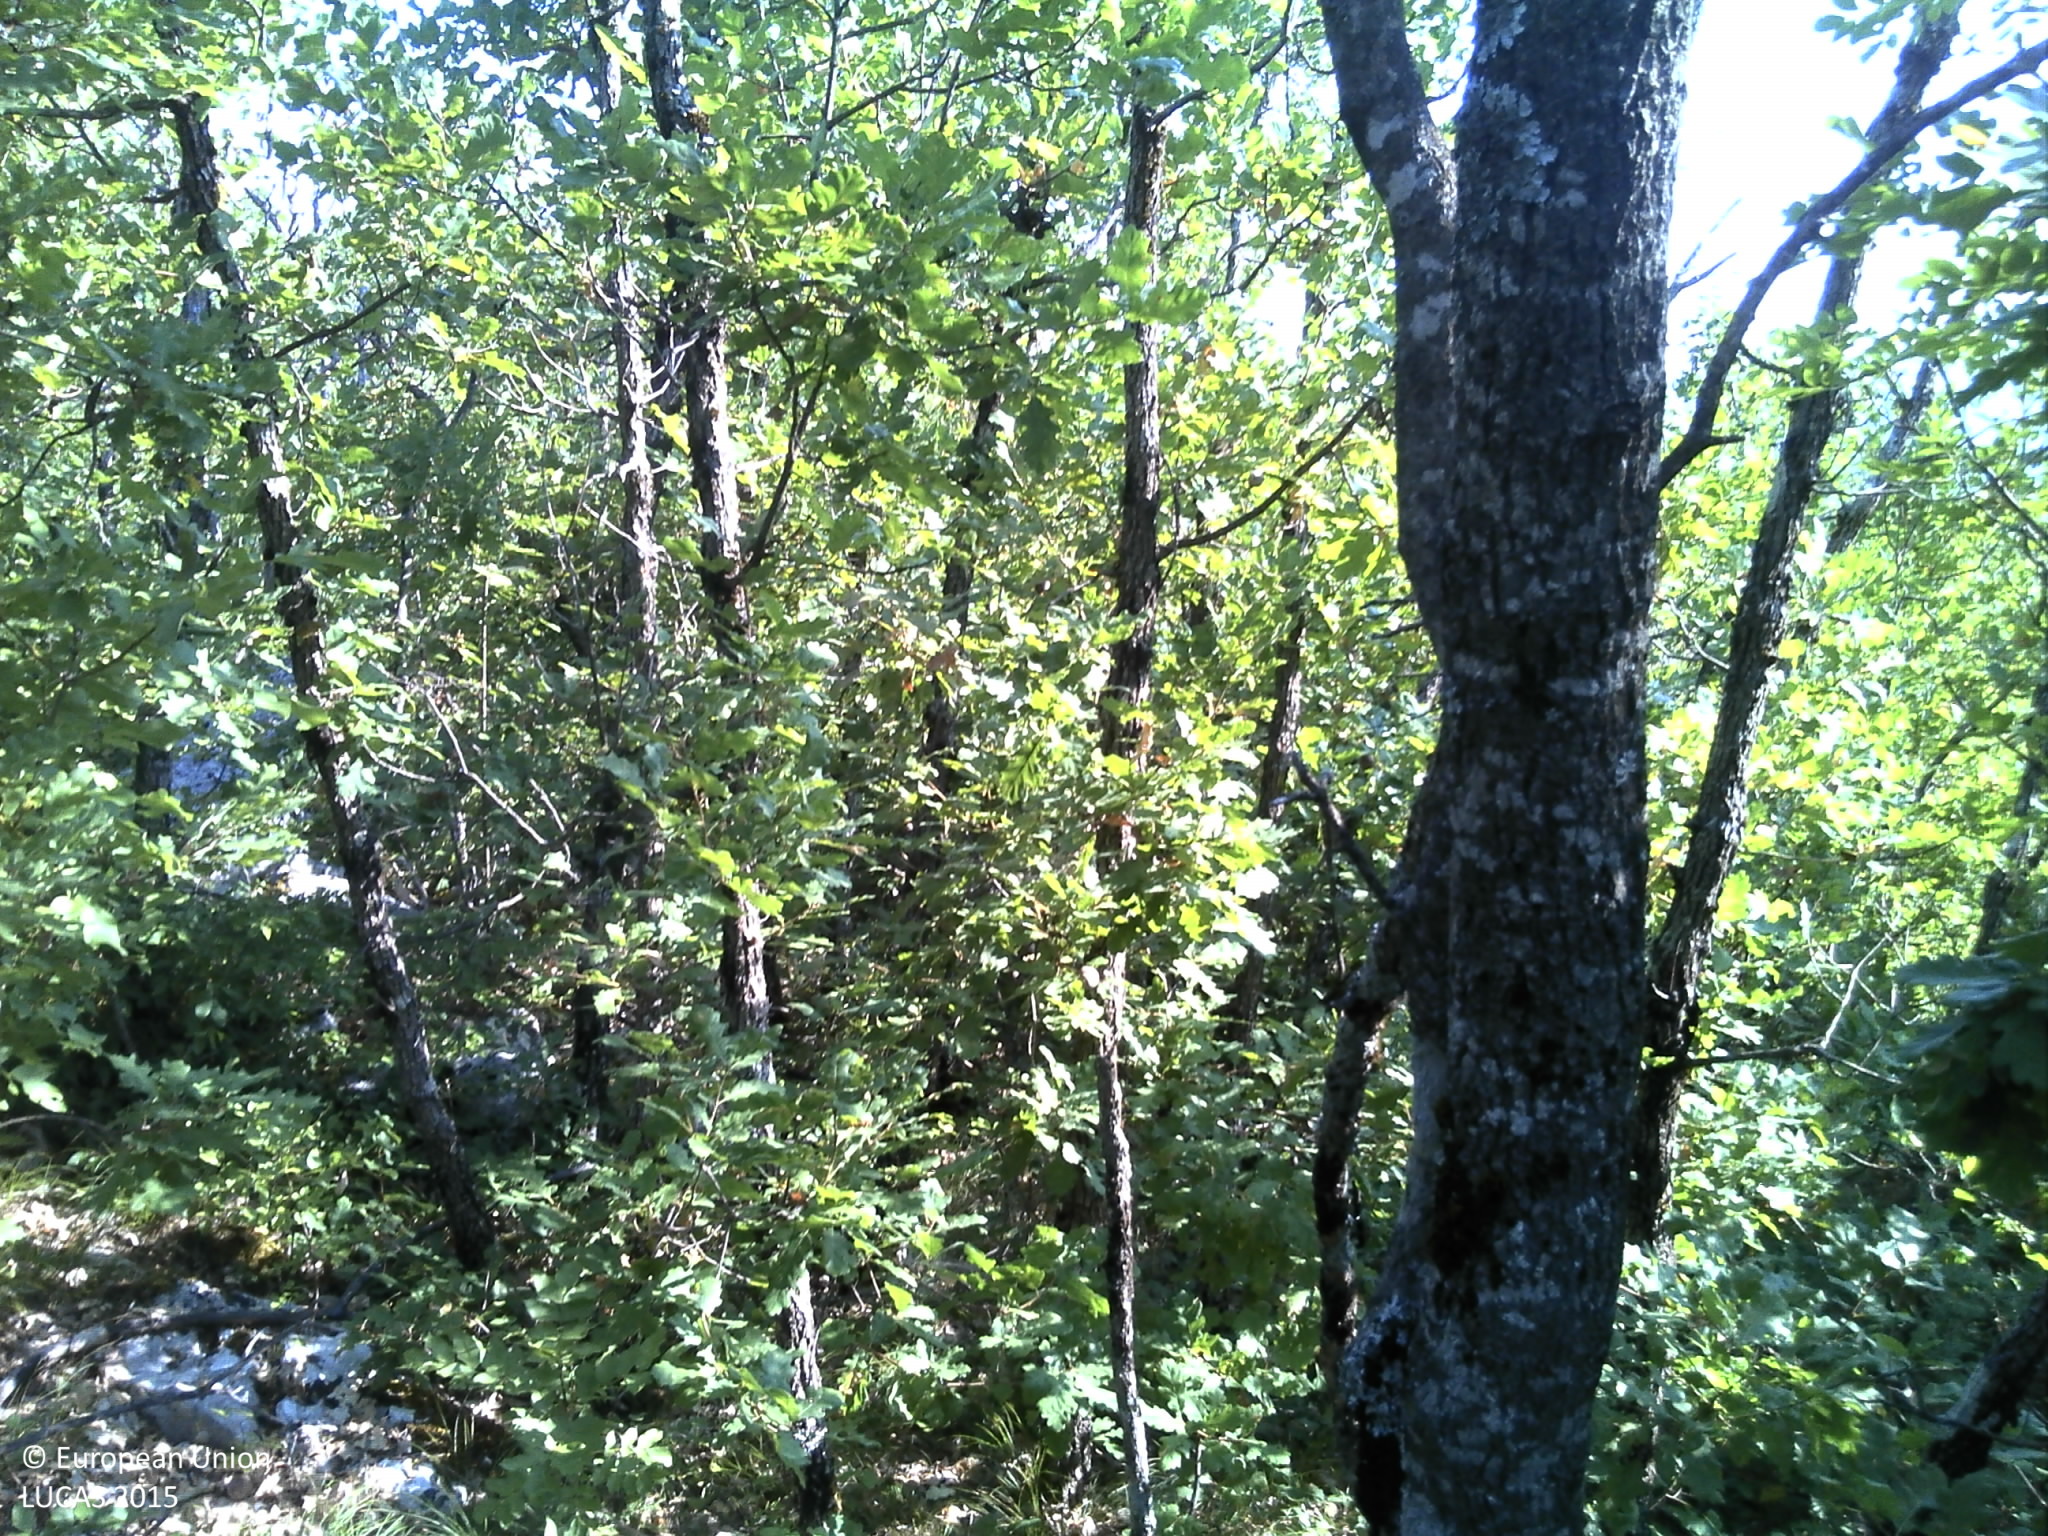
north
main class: Woodland
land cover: Broadleaved woodland
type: thermophilous deciduous forest
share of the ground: > 75 %
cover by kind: broadleaved forest trees 75 %, shrubs 15 %, herbaceous plants 5 %, consolidated bare surface 5 %
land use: Semi-natural and natural areas not in use
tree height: > 5 m
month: July
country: HR
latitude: 43.3820
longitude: 17.1136
